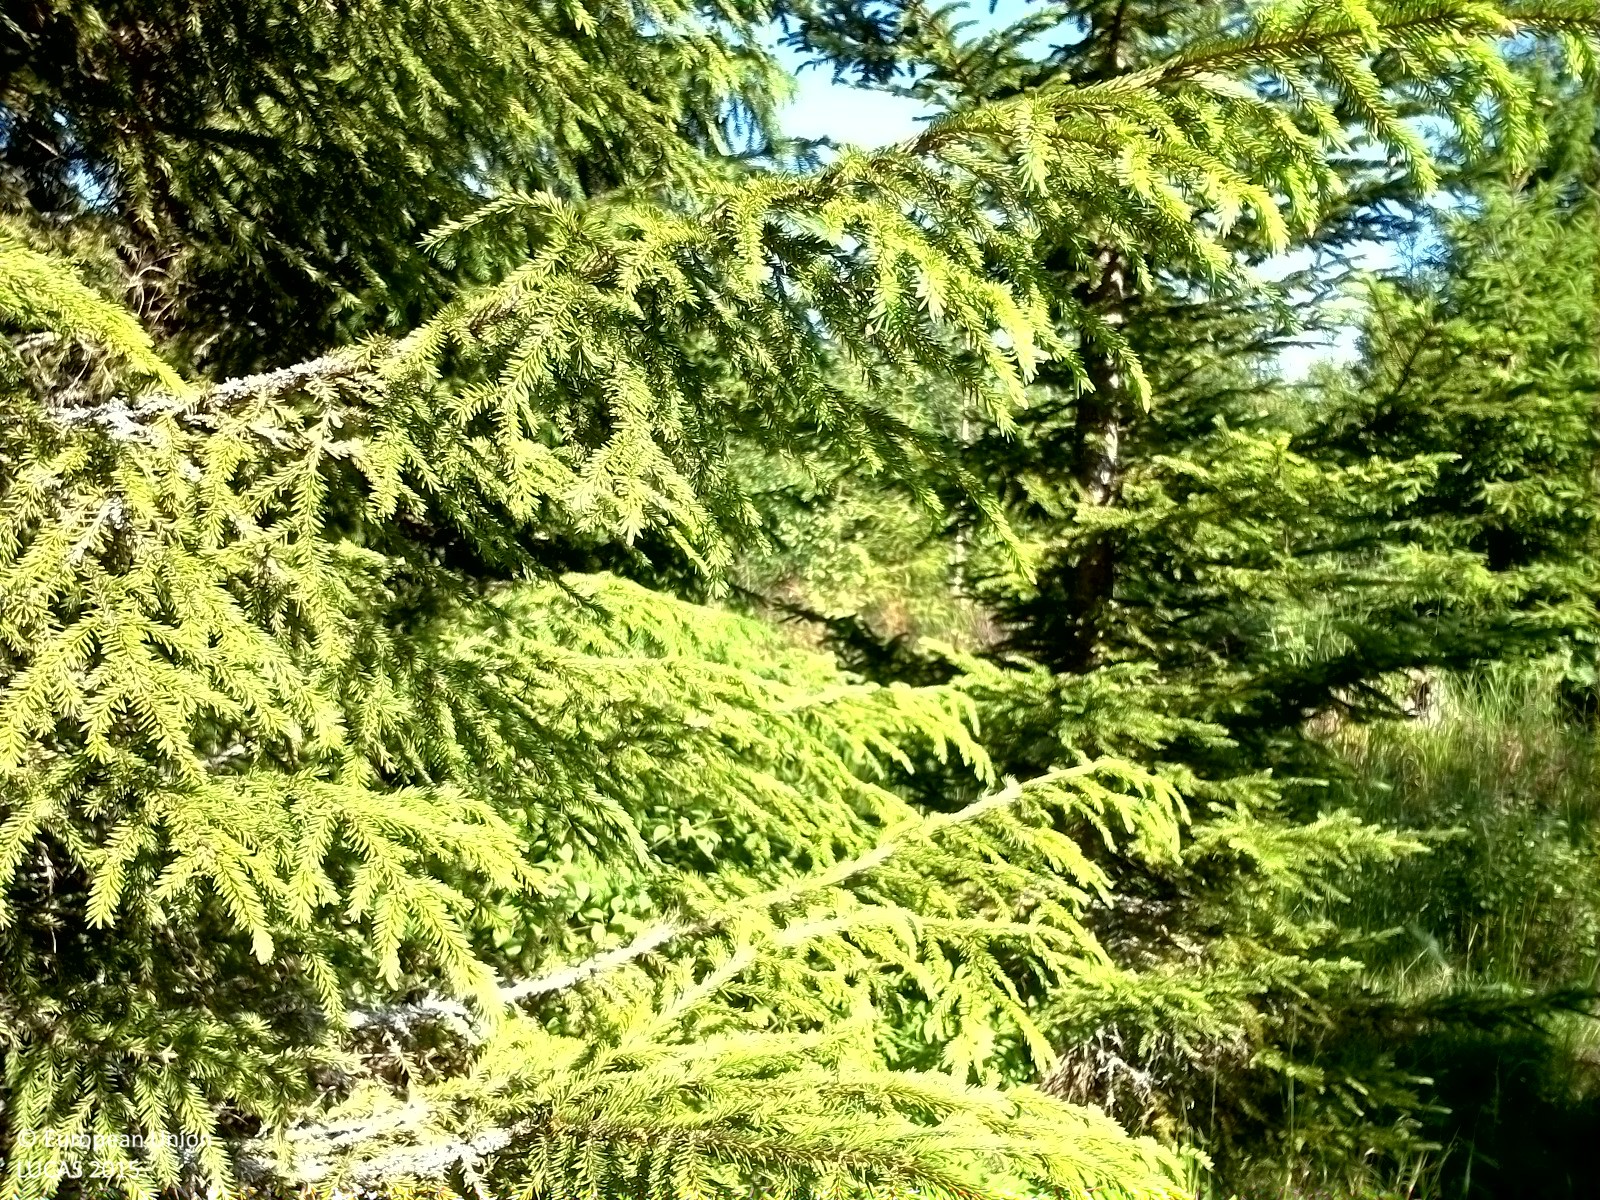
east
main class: Woodland
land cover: Spruce dominated coniferous woodland
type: boreal forest
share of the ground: 25 - 50 %
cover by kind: herbaceous plants 55 %, coniferous forest trees 45 %
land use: Forestry
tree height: > 5 m
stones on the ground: < 10 %
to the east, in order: Spruce dominated coniferous woodland; Pine dominated coniferous woodland; Spruce dominated coniferous woodland; Electric lines; Paved roads, cycling and walking lanes; Spruce dominated mixed woodland; Pine dominated mixed woodland
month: July
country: SE
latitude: 62.2177
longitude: 16.9234
